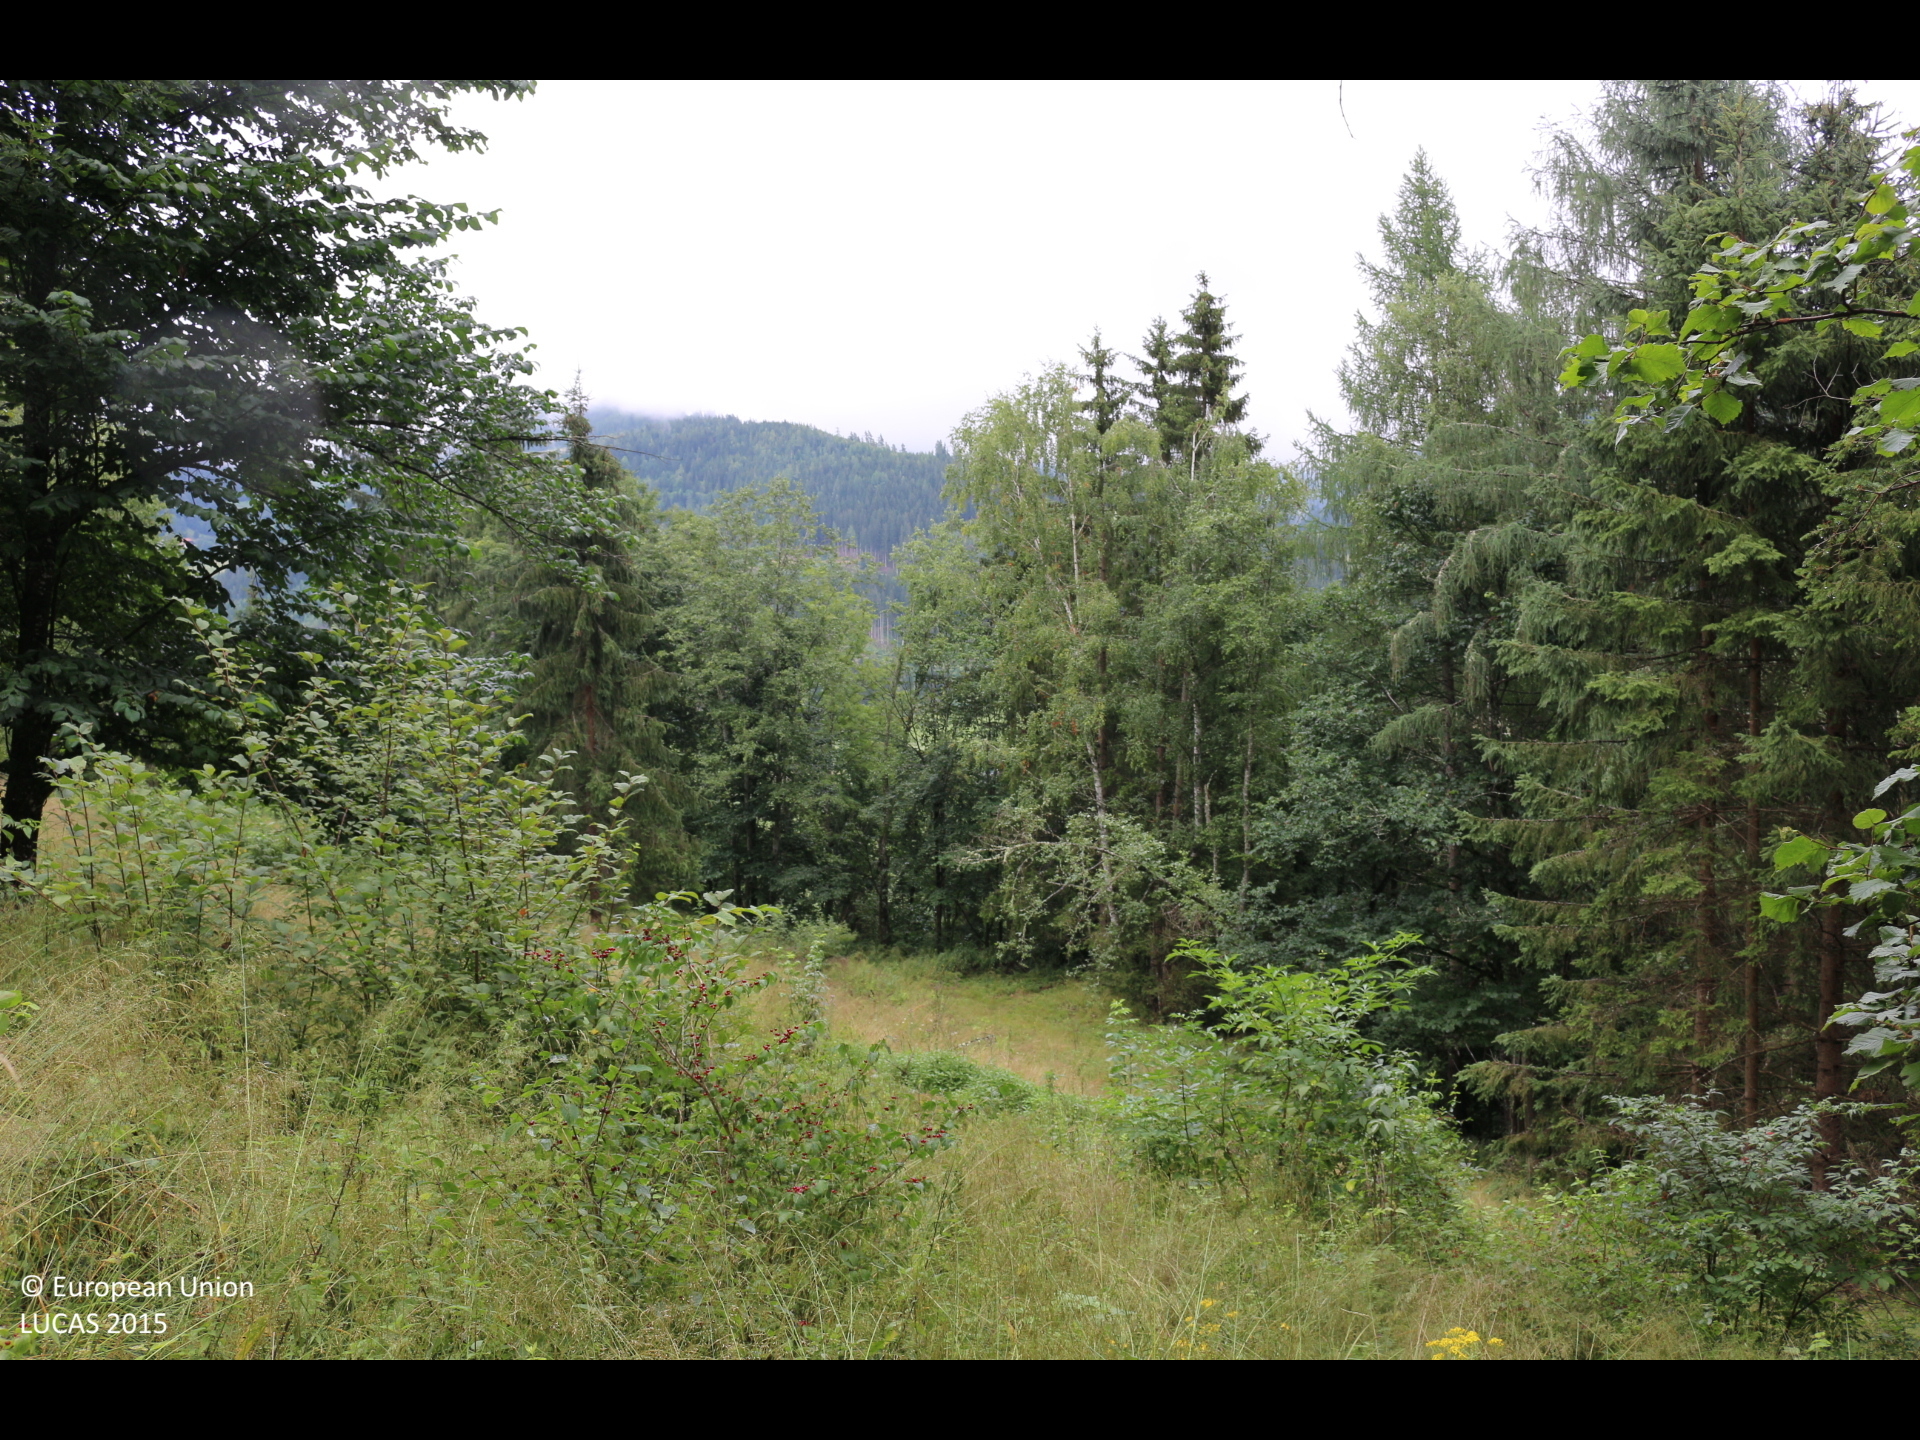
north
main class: Woodland
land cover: Spruce dominated mixed woodland
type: mountainous beech forest
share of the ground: > 75 %
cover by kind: coniferous forest trees 65 %, broadleaved forest trees 25 %, shrubs 5 %, herbaceous plants 5 %
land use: Forestry
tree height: > 5 m
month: July
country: AT
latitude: 46.9682
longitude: 14.2959
